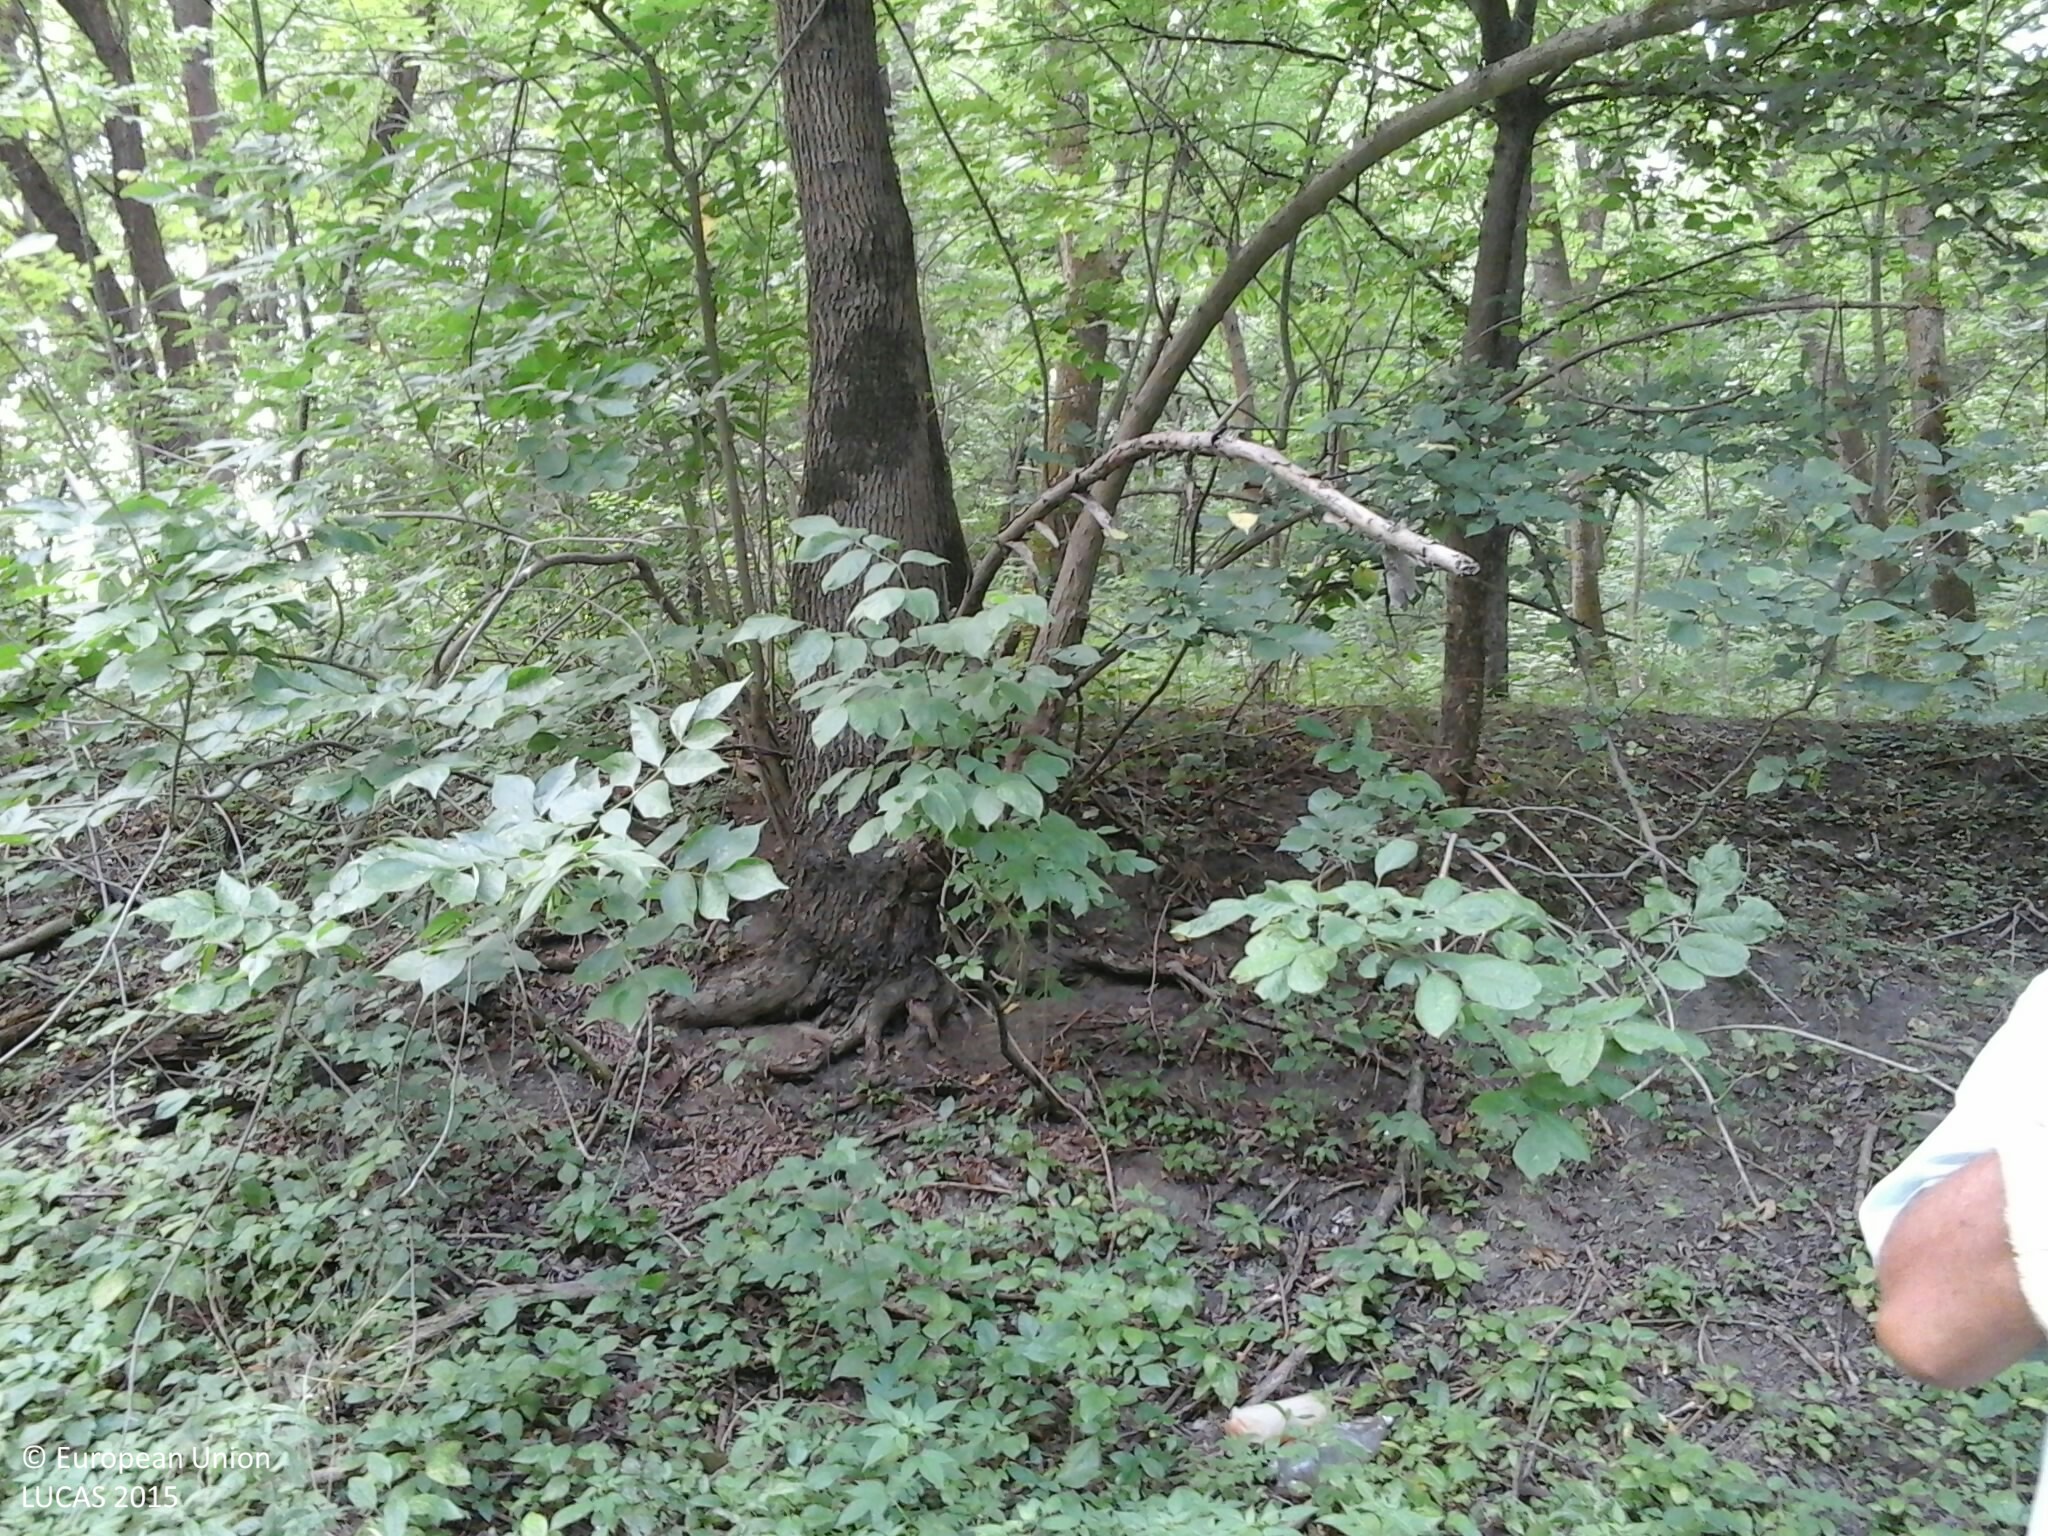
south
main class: Woodland
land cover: Broadleaved woodland
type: mesophytic deciduous forest
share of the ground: > 75 %
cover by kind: broadleaved forest trees 100 %
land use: Forestry
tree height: > 5 m
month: July
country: HU
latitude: 47.7630
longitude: 20.9913
